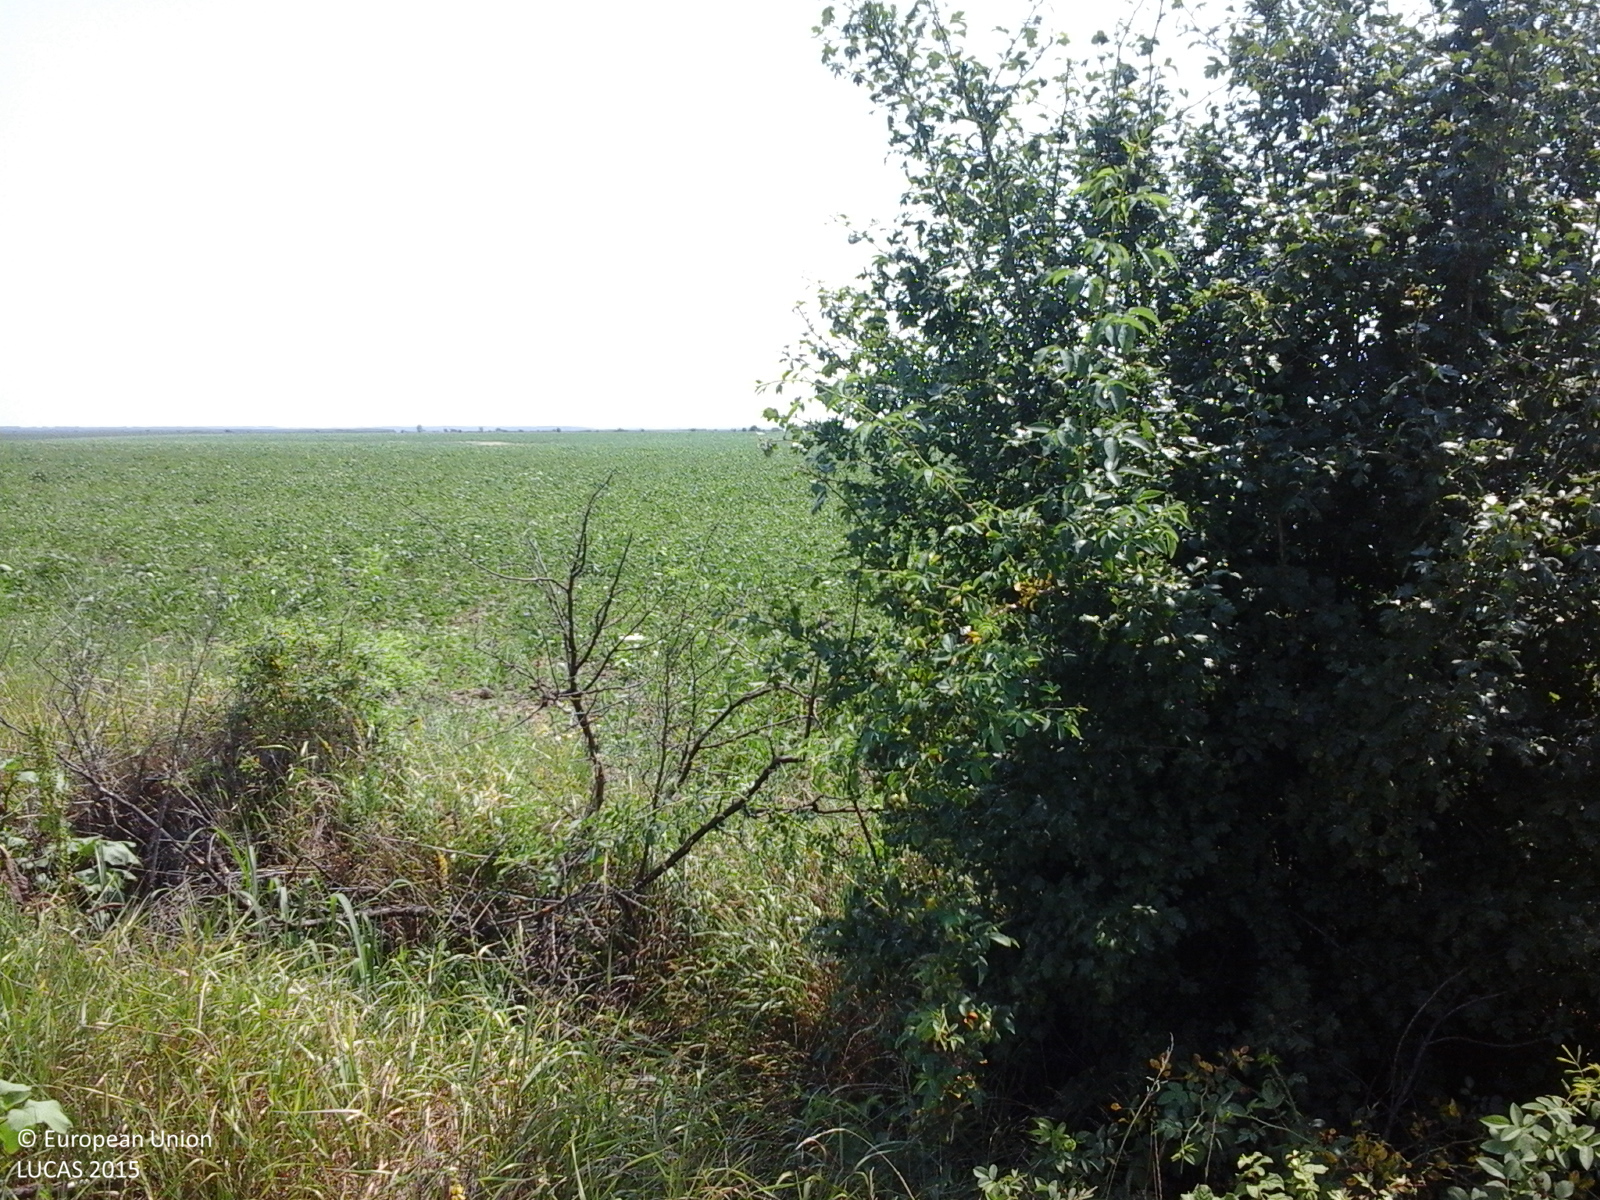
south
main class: Grassland
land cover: Spontaneously vegetated surfaces
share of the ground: > 75 %
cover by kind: herbaceous plants 100 %
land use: Fallow land
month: July
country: RO
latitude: 44.7720
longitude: 25.6267
